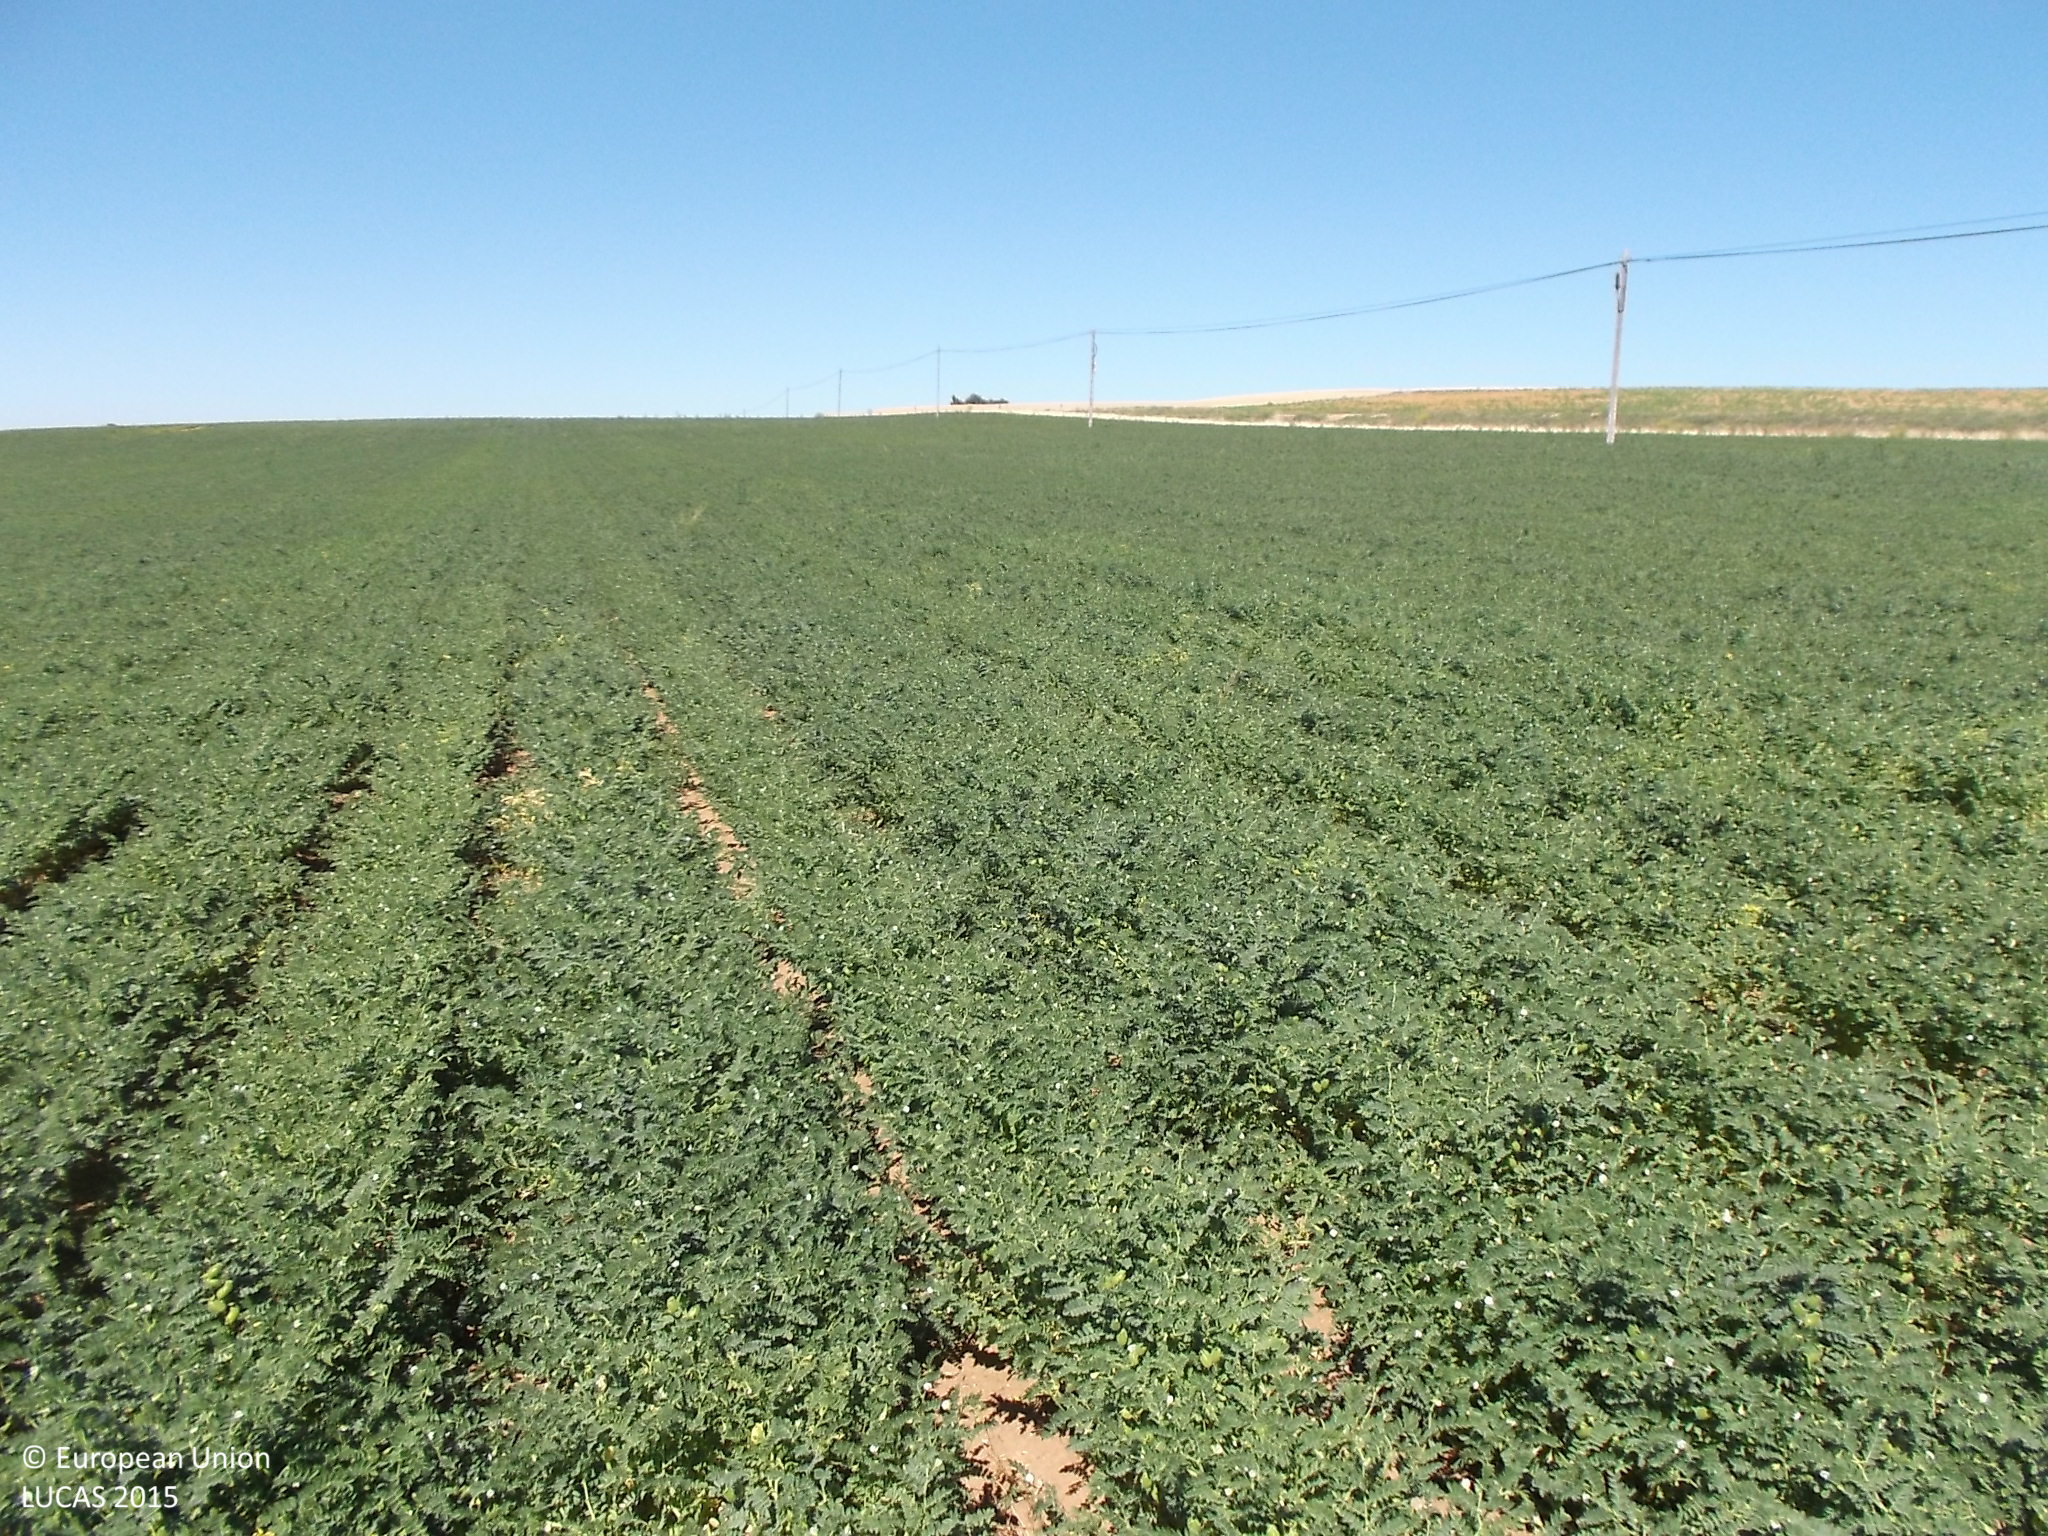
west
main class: Cropland
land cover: Dry pulses
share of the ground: > 75 %
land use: Agriculture (excluding fallow land and kitchen gardens)
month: June
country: ES
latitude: 41.2462
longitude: -5.4102
